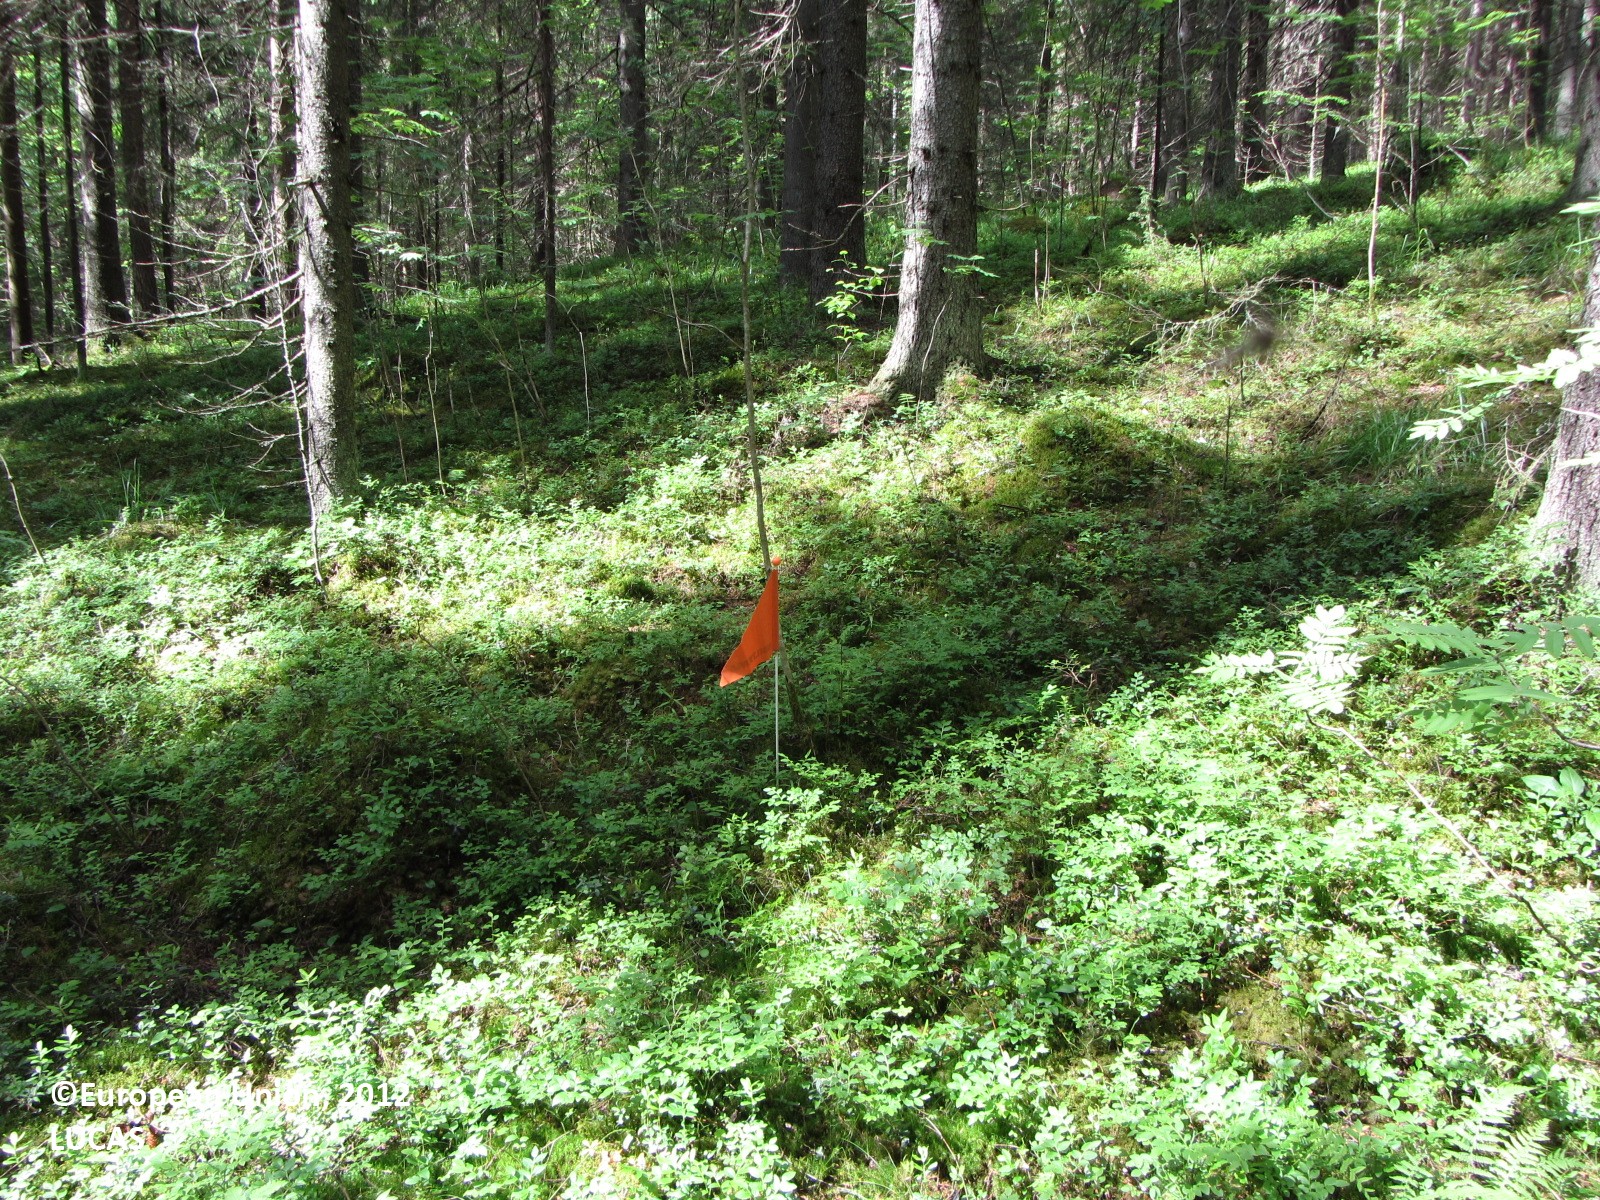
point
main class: Woodland
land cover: Spruce dominated coniferous woodland
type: boreal forest
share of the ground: > 75 %
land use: Forestry
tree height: > 5 m
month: June
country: FI
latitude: 61.9907
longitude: 25.2865
